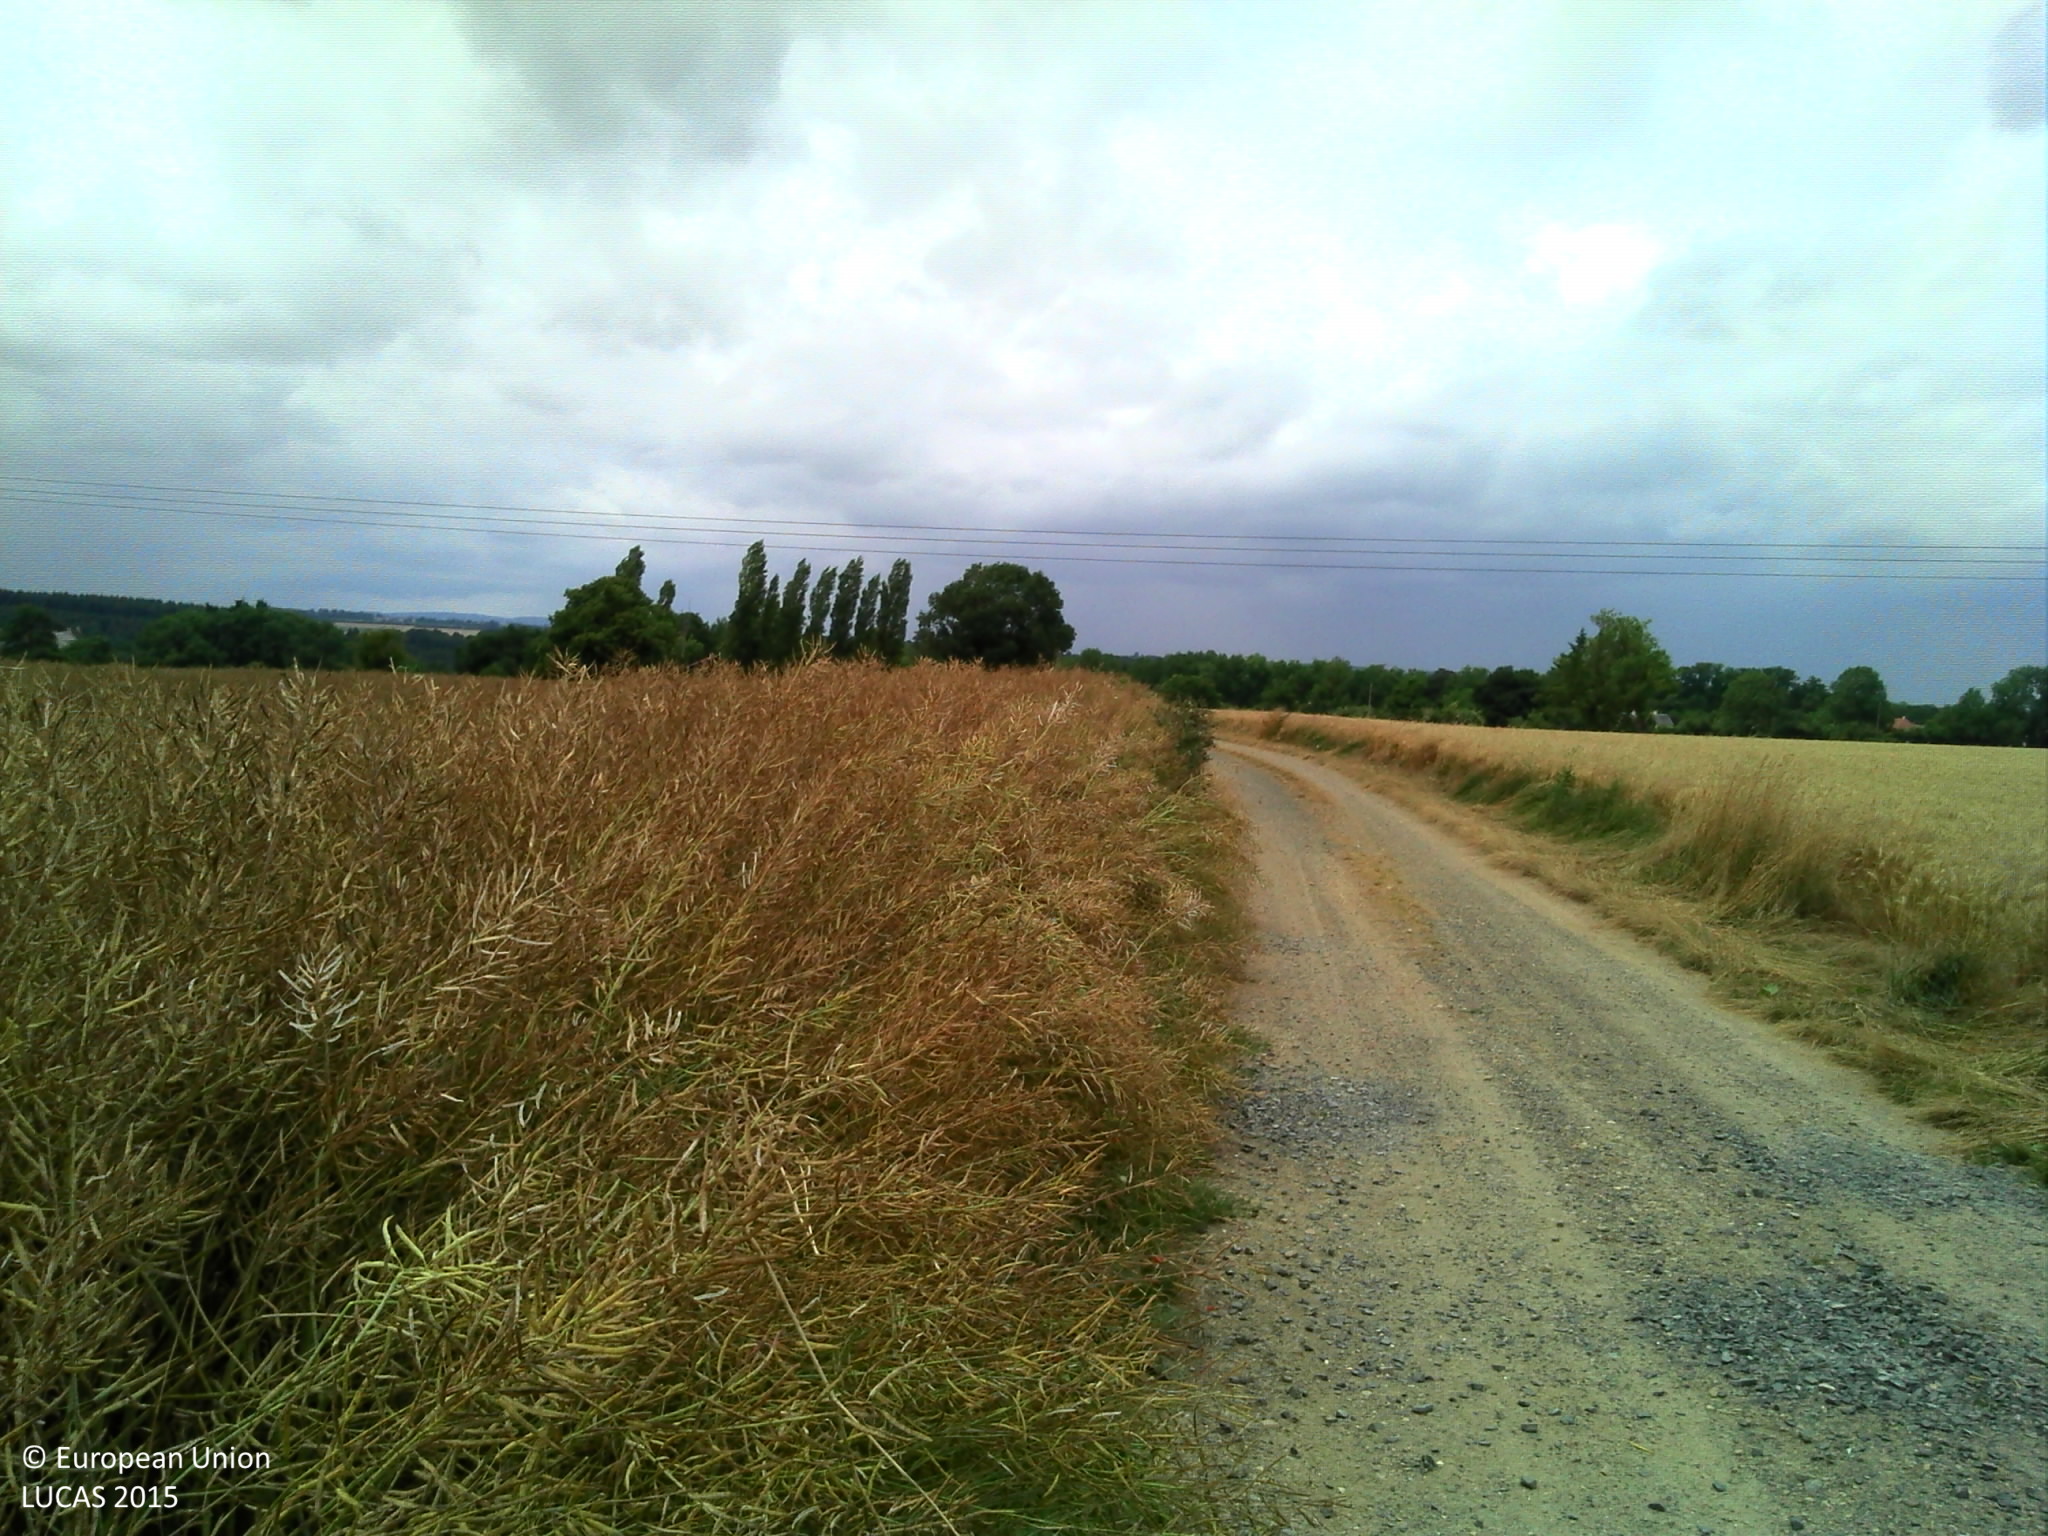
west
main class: Cropland
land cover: Rape and turnip rape
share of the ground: > 75 %
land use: Agriculture (excluding fallow land and kitchen gardens)
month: July
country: FR
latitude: 48.9915
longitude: -0.2974
